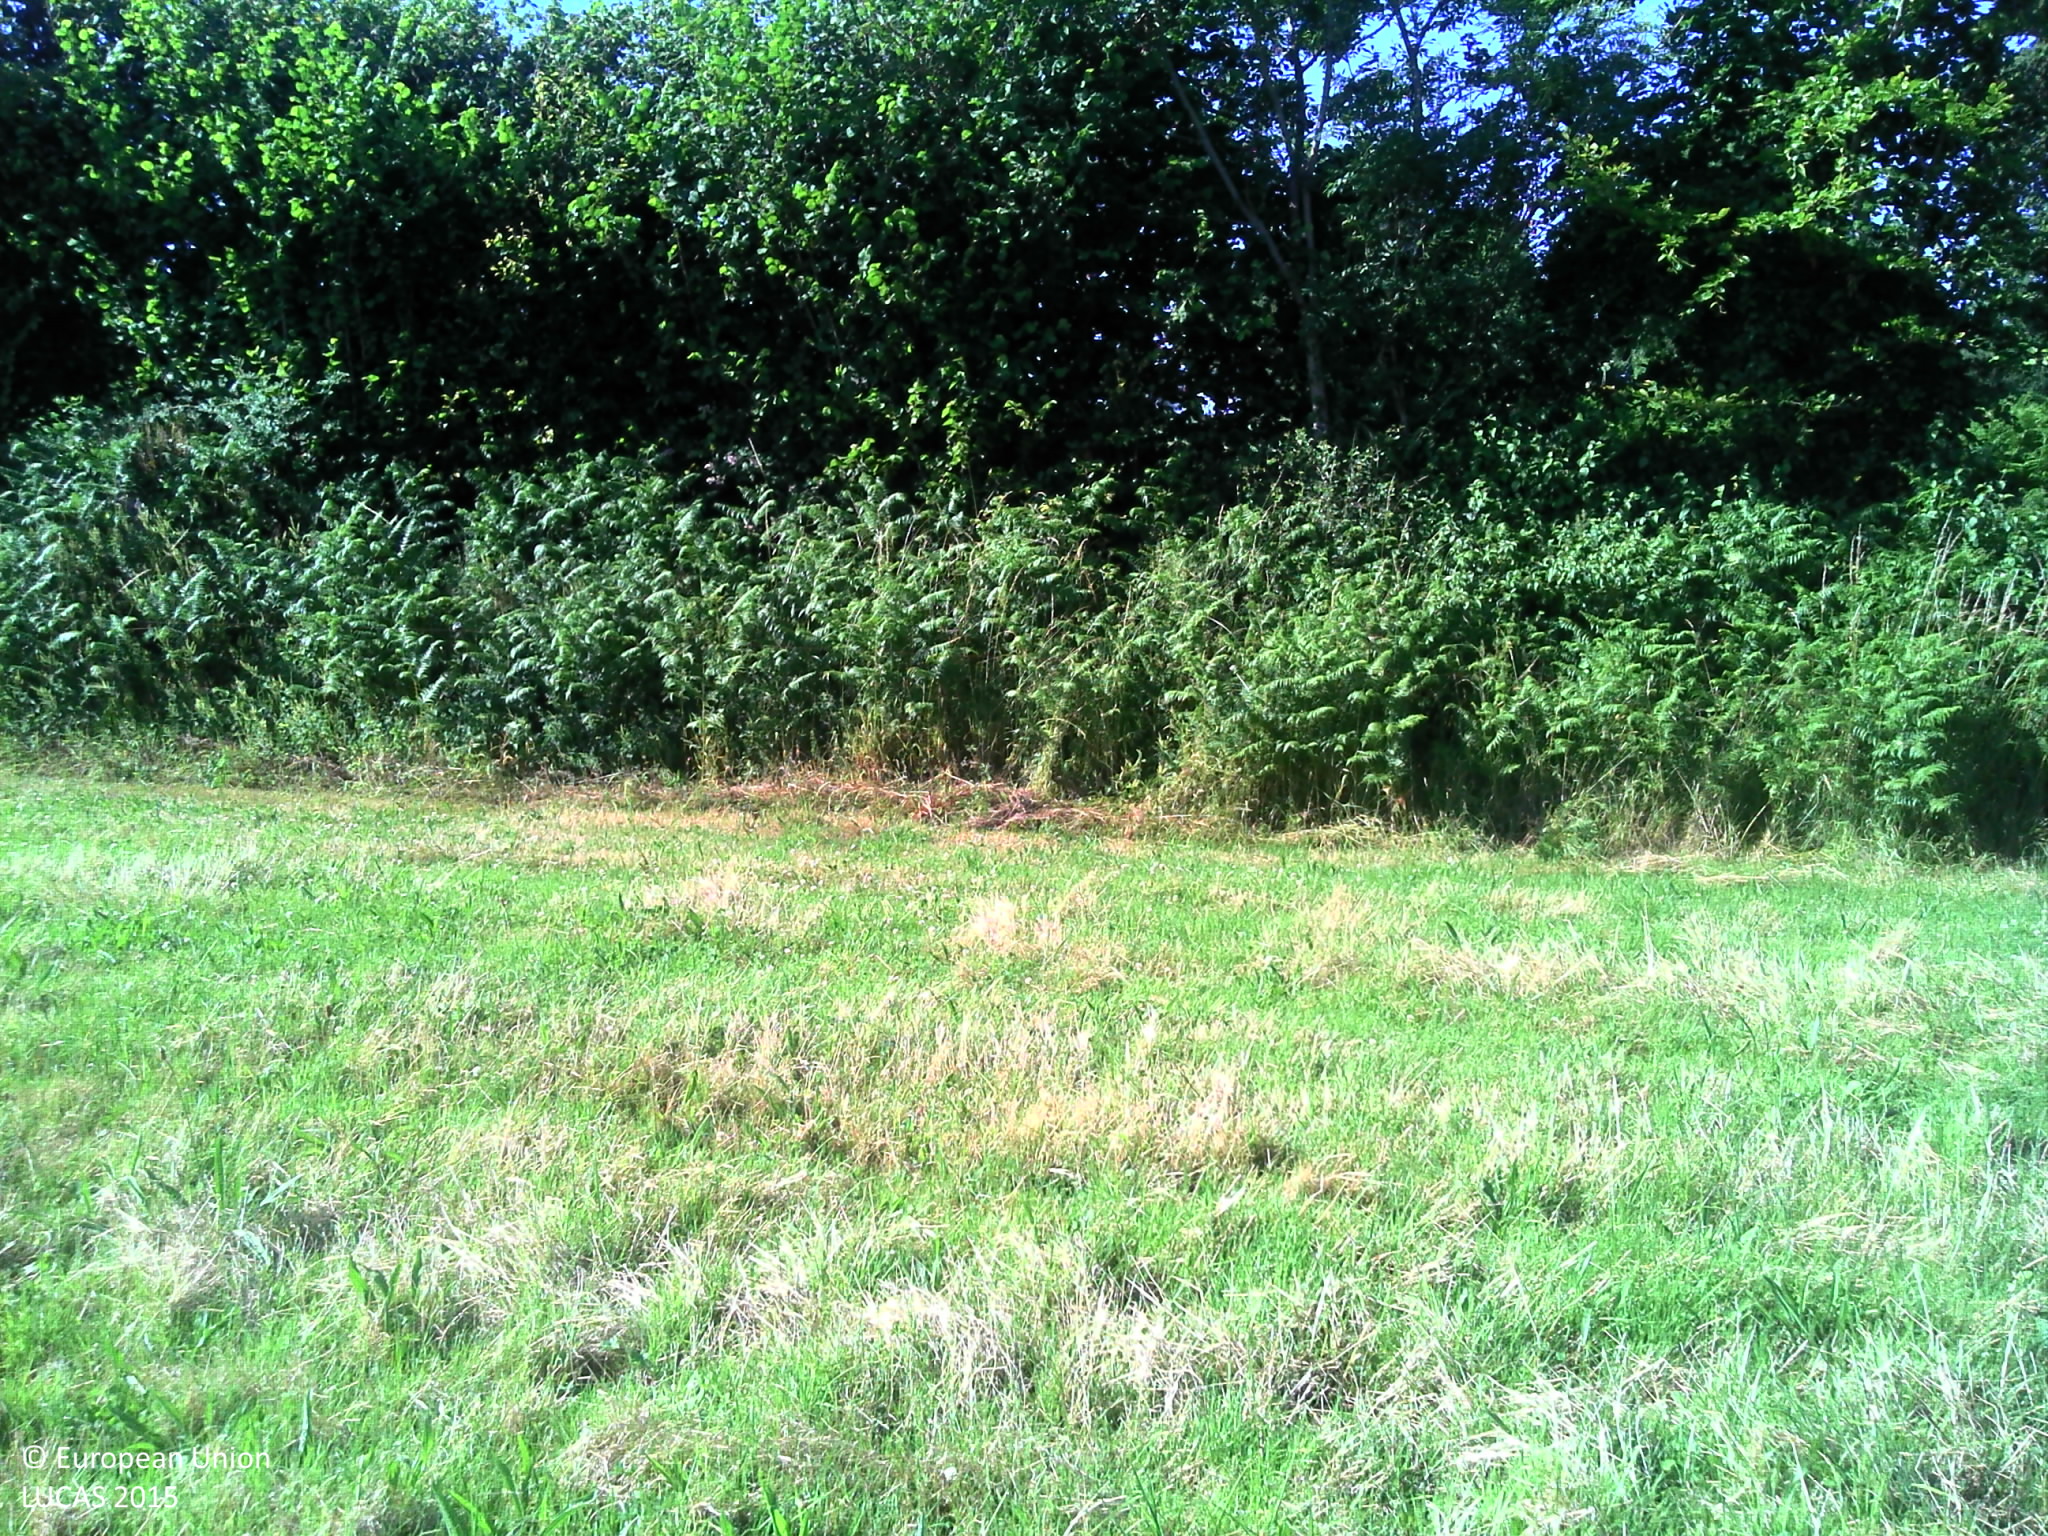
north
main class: Grassland
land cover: Grassland without tree/shrub cover
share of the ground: > 75 %
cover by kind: herbaceous plants 100 %
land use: Agriculture (excluding fallow land and kitchen gardens)
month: July
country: FR
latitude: 49.0211
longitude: -1.3000
